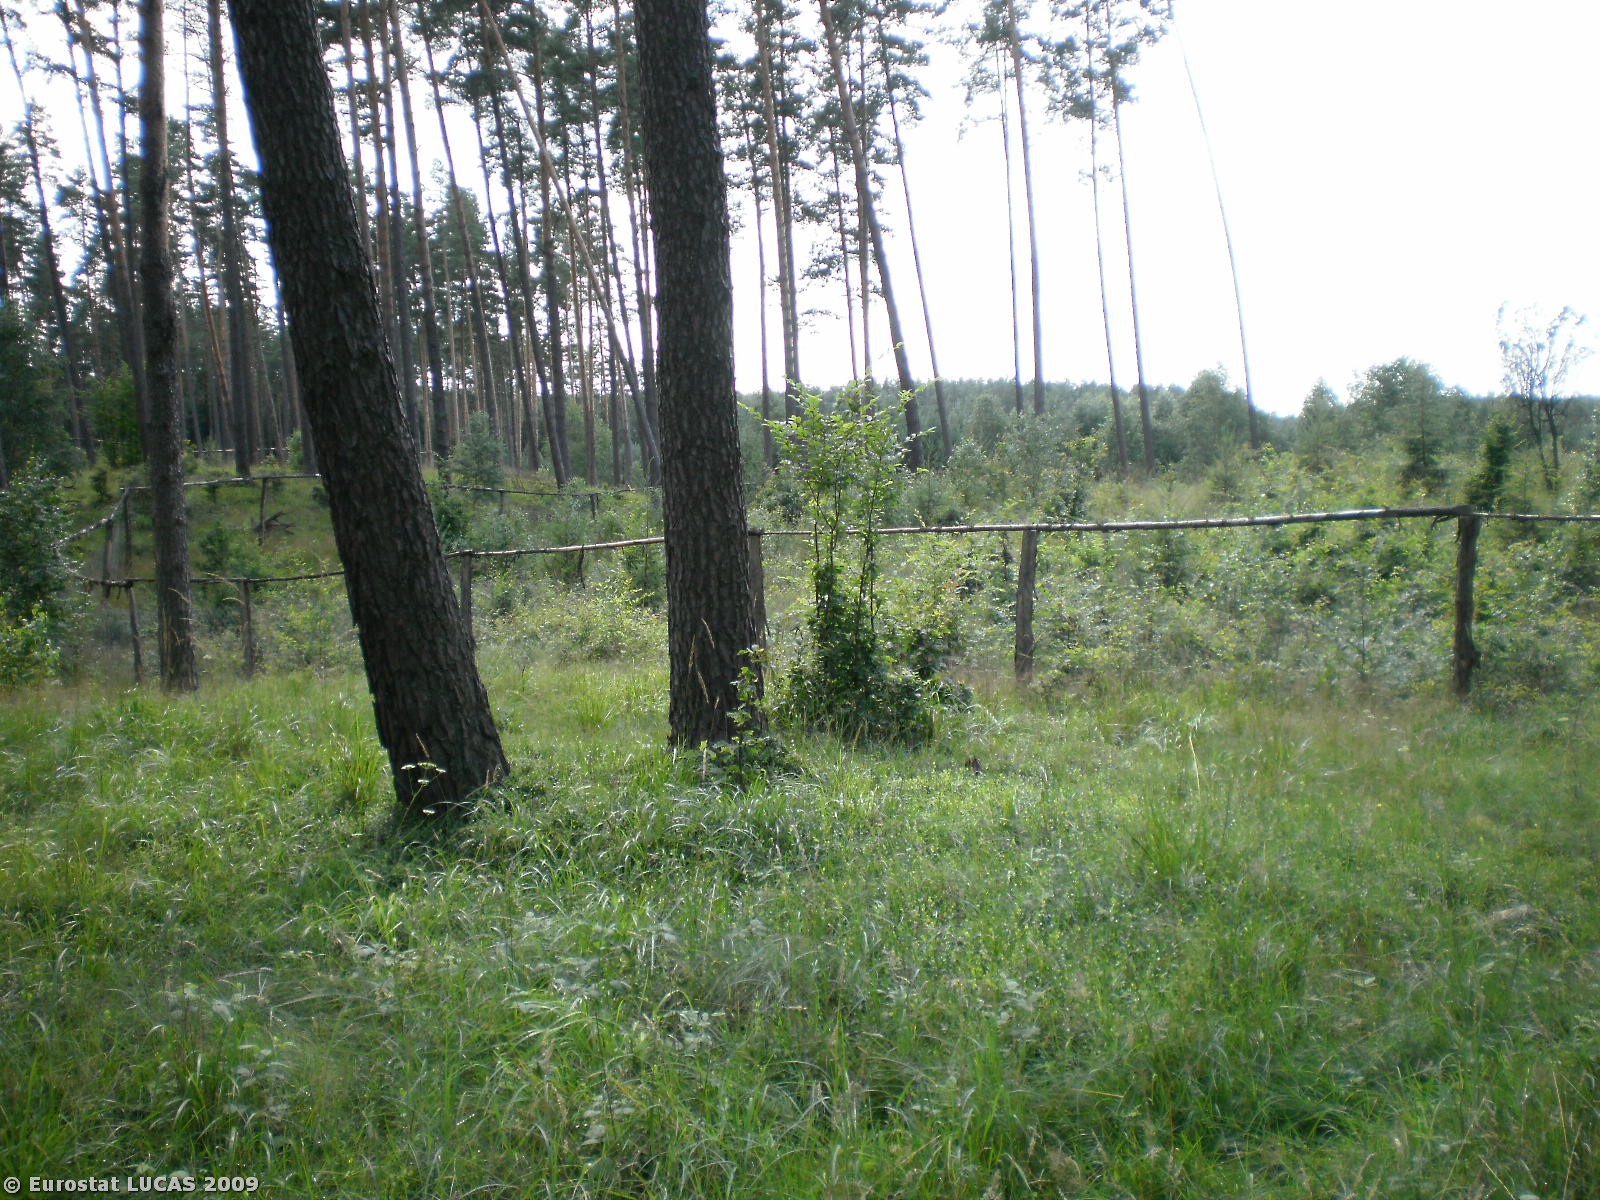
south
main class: Woodland
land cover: Coniferous woodland
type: hemiboreal forest and nemoral coniferous forest and mixed broadleaved-coniferous forest
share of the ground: 25 - 50 %
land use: Forestry
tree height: > 5 m
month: July
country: PL
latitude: 53.4543
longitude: 20.4730
